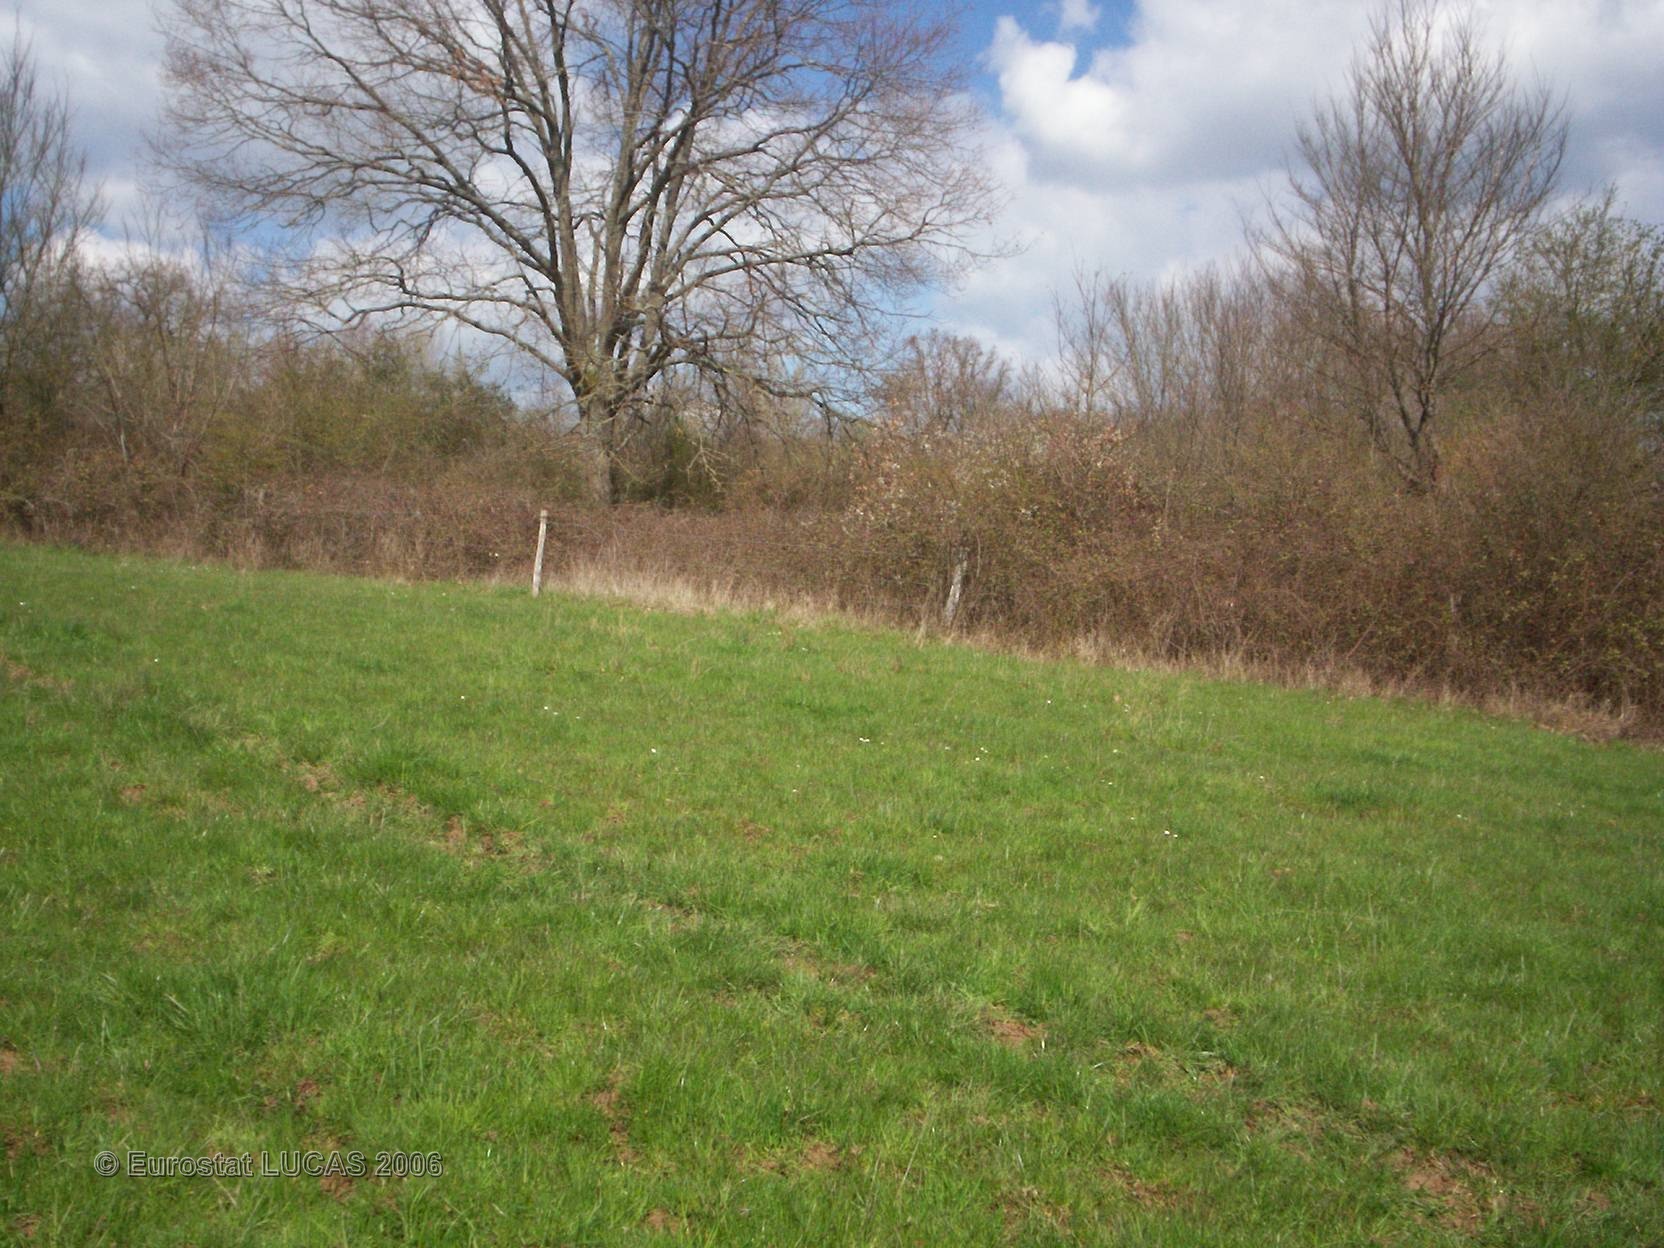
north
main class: Grassland
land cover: Grassland without tree/shrub cover
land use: Agriculture (excluding fallow land and kitchen gardens)
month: April
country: FR
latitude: 46.7606
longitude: 3.0968
